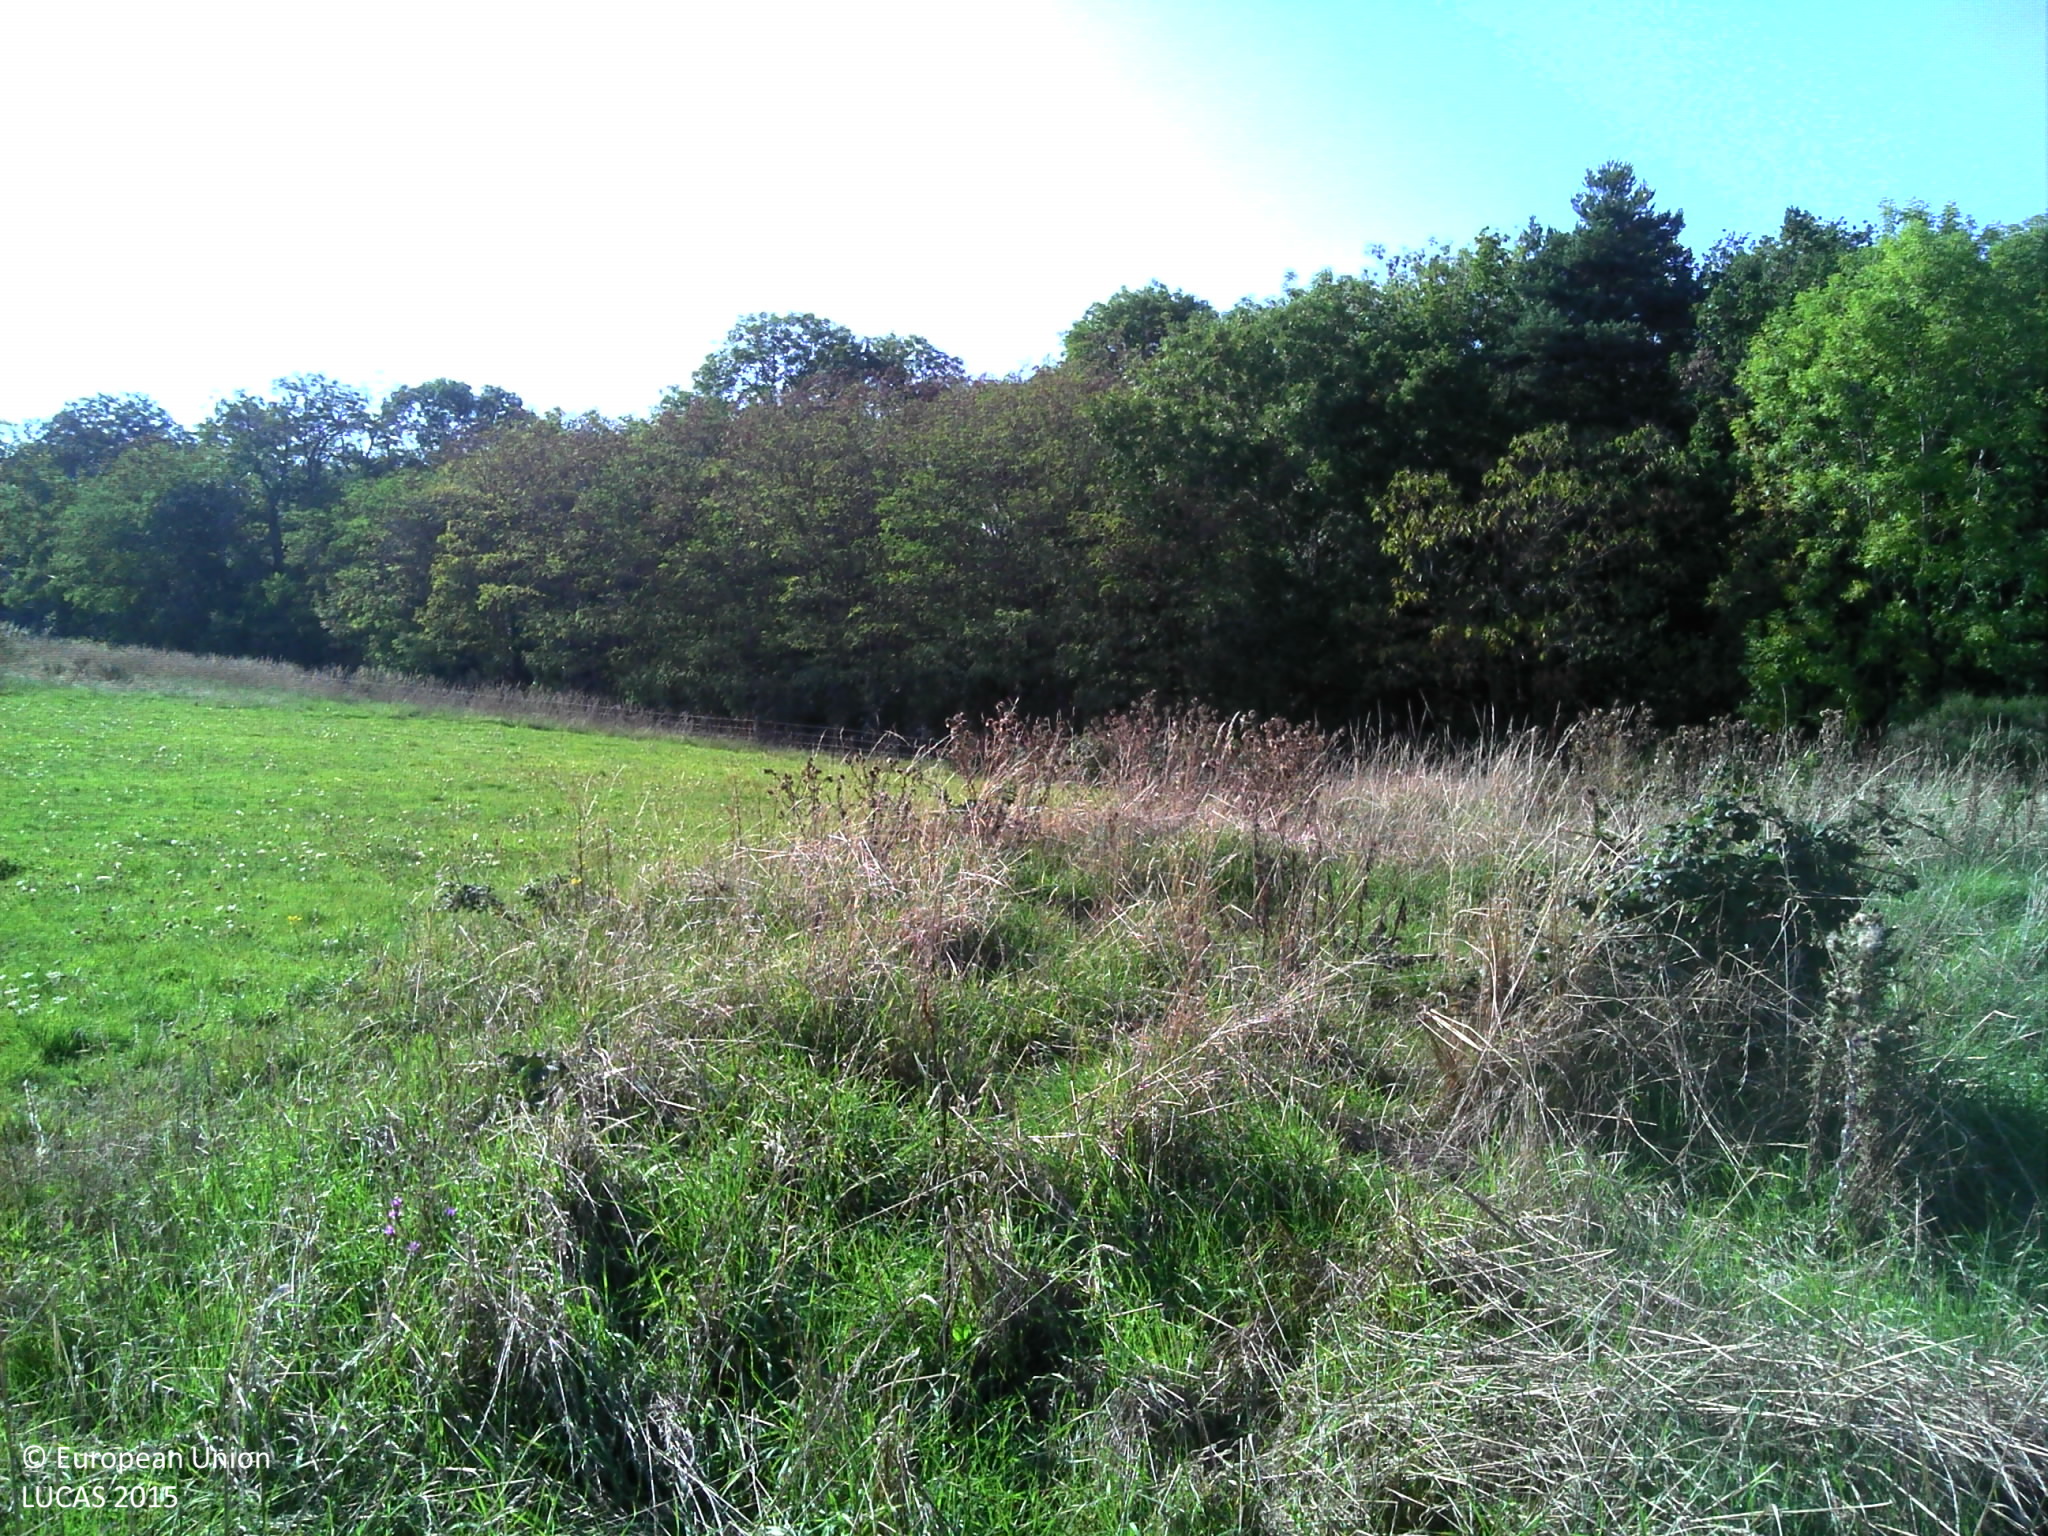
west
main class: Grassland
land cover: Grassland without tree/shrub cover
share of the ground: > 75 %
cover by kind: herbaceous plants 100 %
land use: Agriculture (excluding fallow land and kitchen gardens)
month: October
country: FR
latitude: 45.9619
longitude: 3.0439
